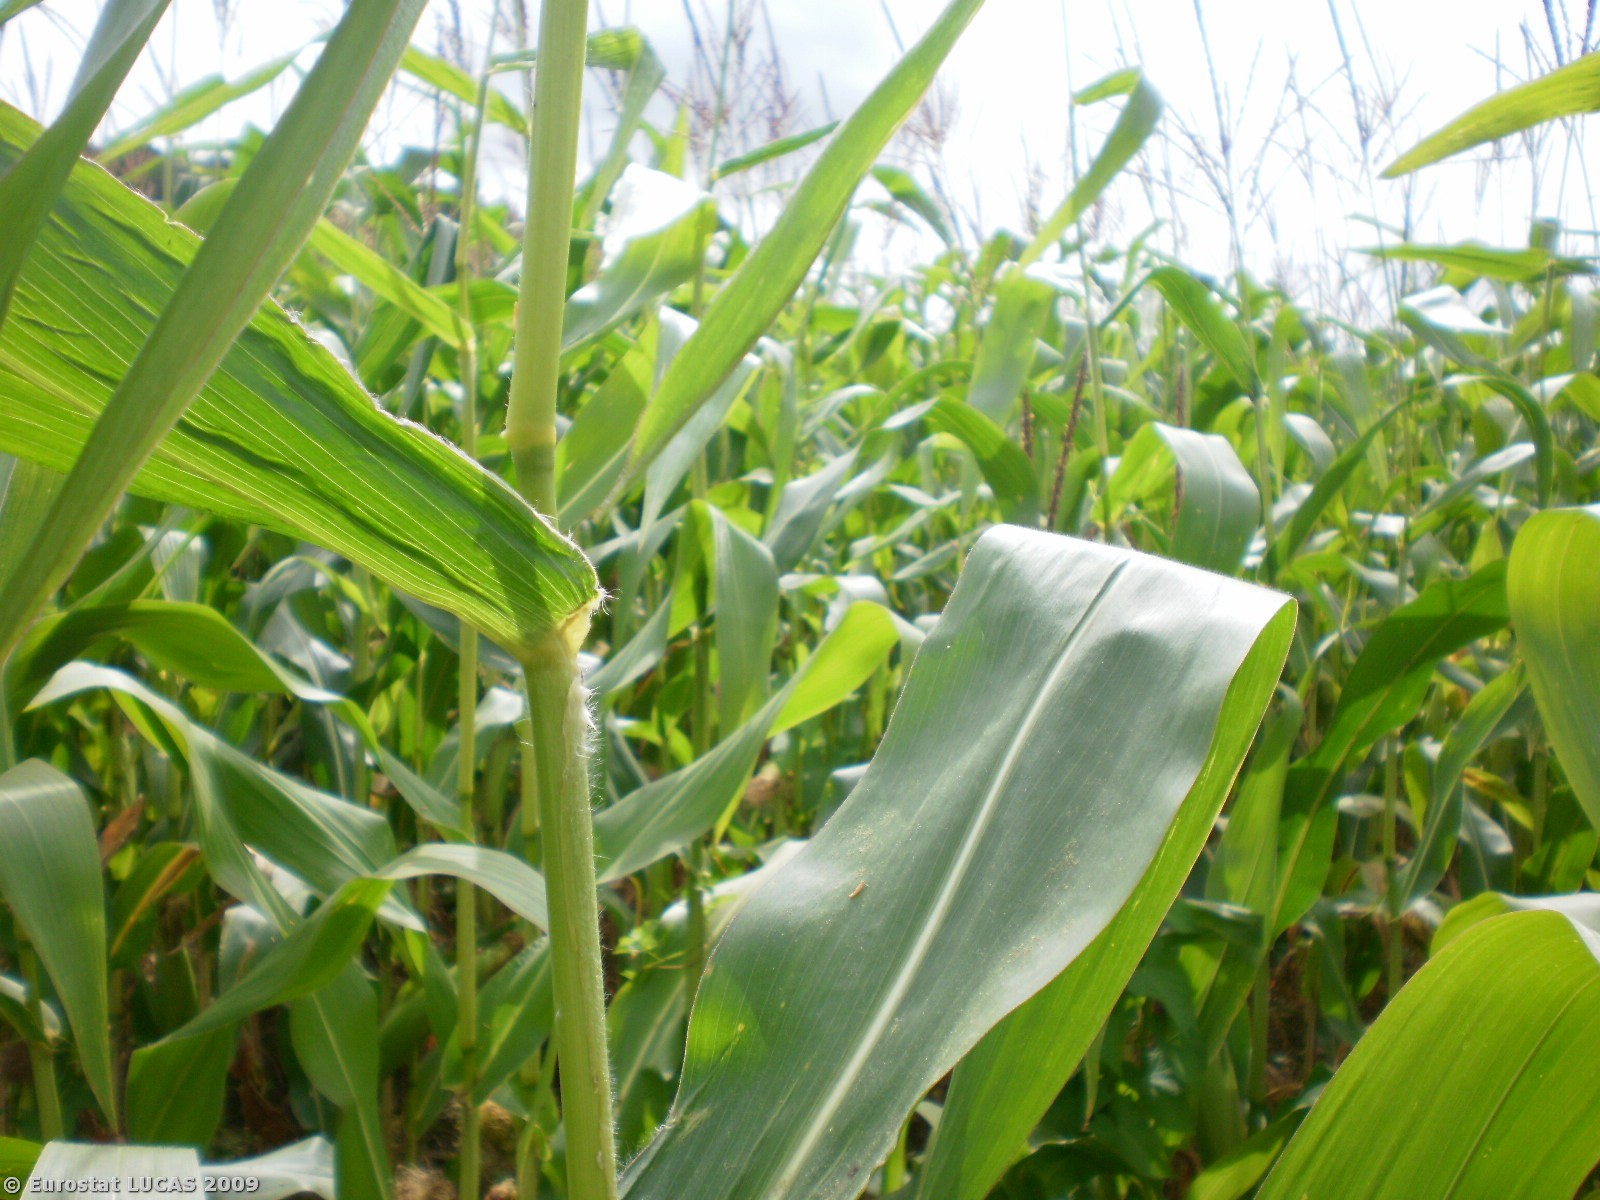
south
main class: Cropland
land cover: Maize
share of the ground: > 75 %
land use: Agriculture (excluding fallow land and kitchen gardens)
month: August
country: BE
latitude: 50.4412
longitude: 5.5911
